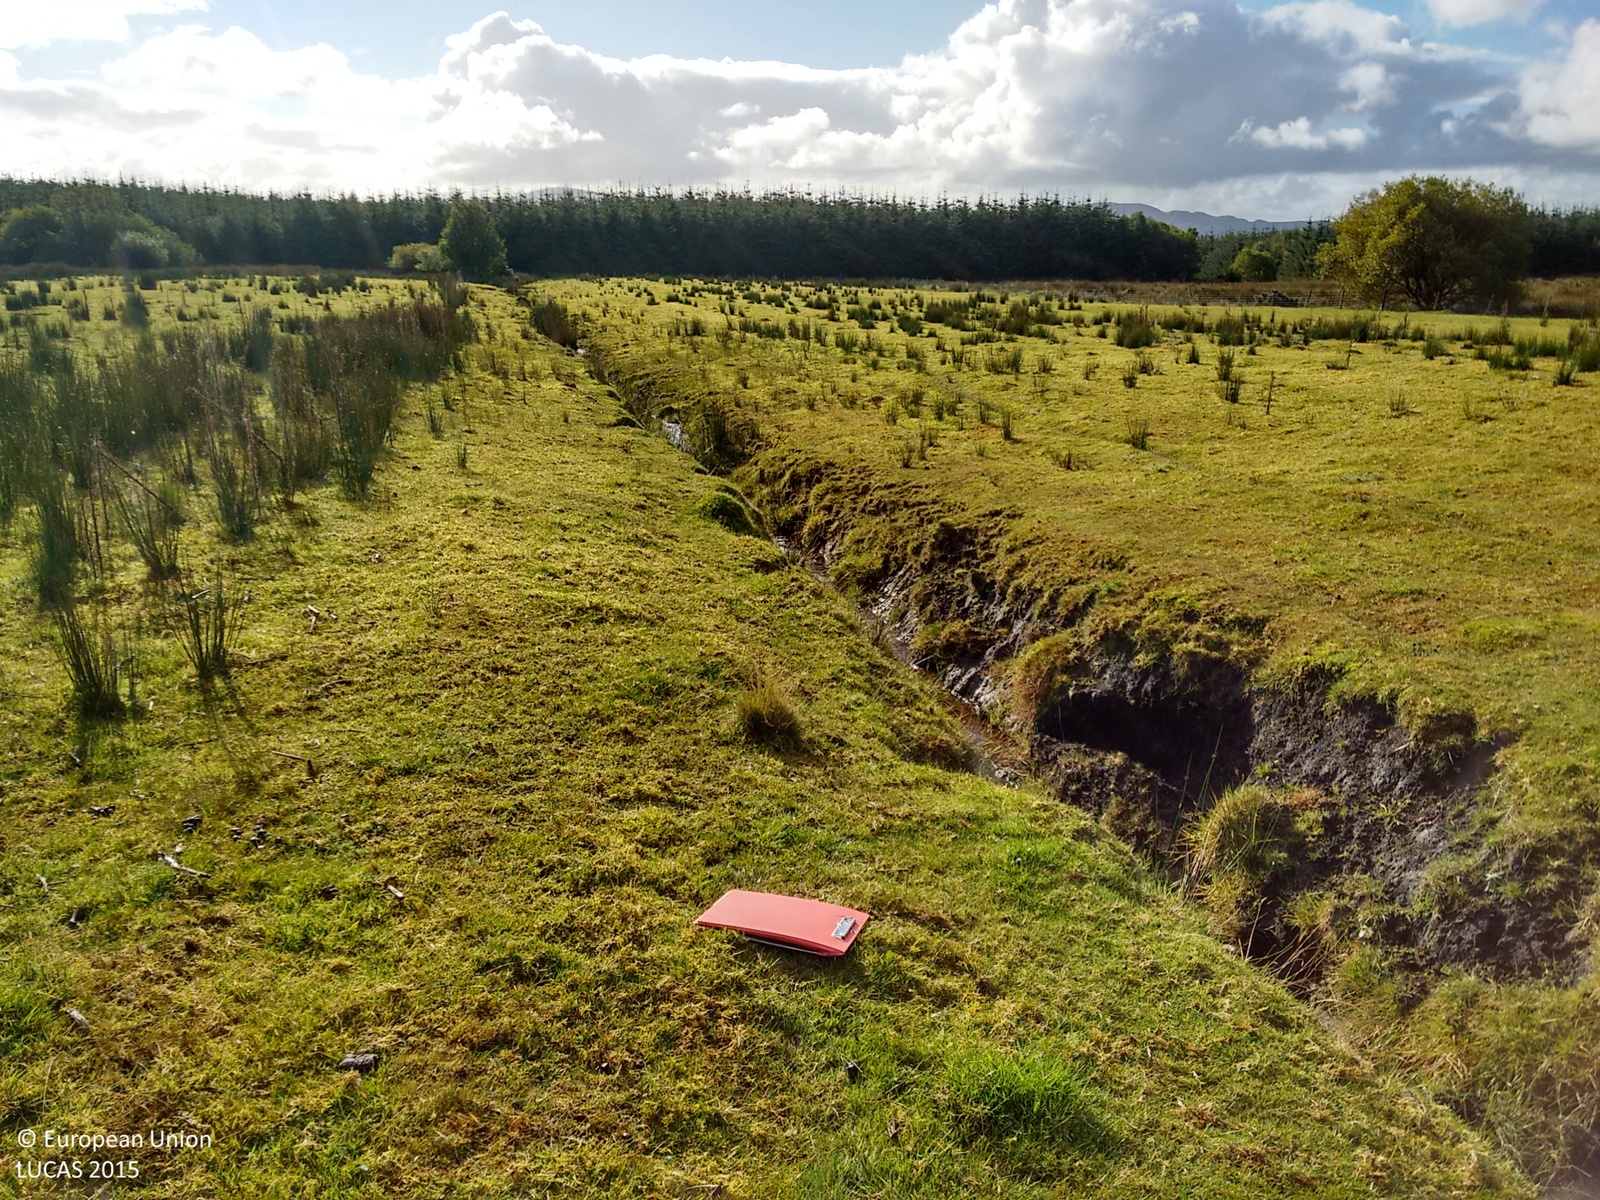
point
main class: Grassland
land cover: Grassland without tree/shrub cover
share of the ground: > 75 %
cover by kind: herbaceous plants 100 %
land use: Agriculture (excluding fallow land and kitchen gardens)
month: September
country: IE
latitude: 55.1773
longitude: -7.4722
